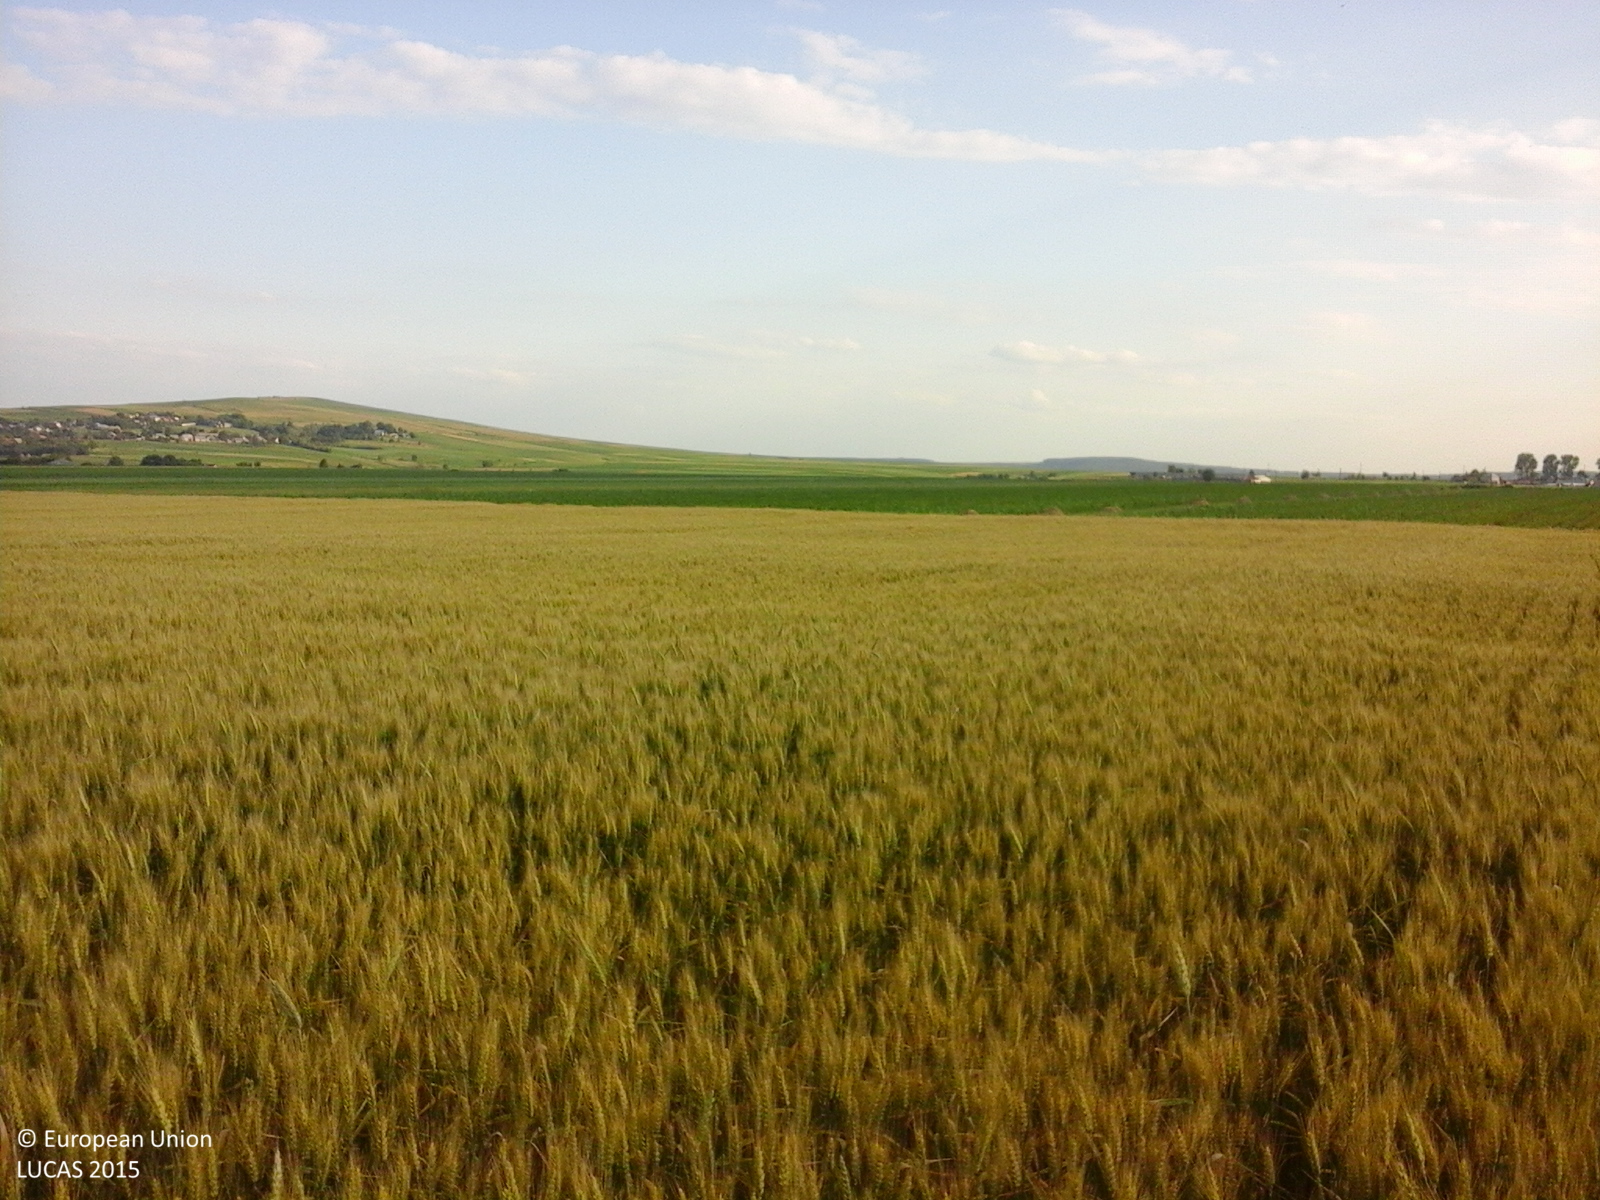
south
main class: Cropland
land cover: Common wheat
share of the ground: > 75 %
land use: Agriculture (excluding fallow land and kitchen gardens)
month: June
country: RO
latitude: 47.8058
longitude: 26.3091
